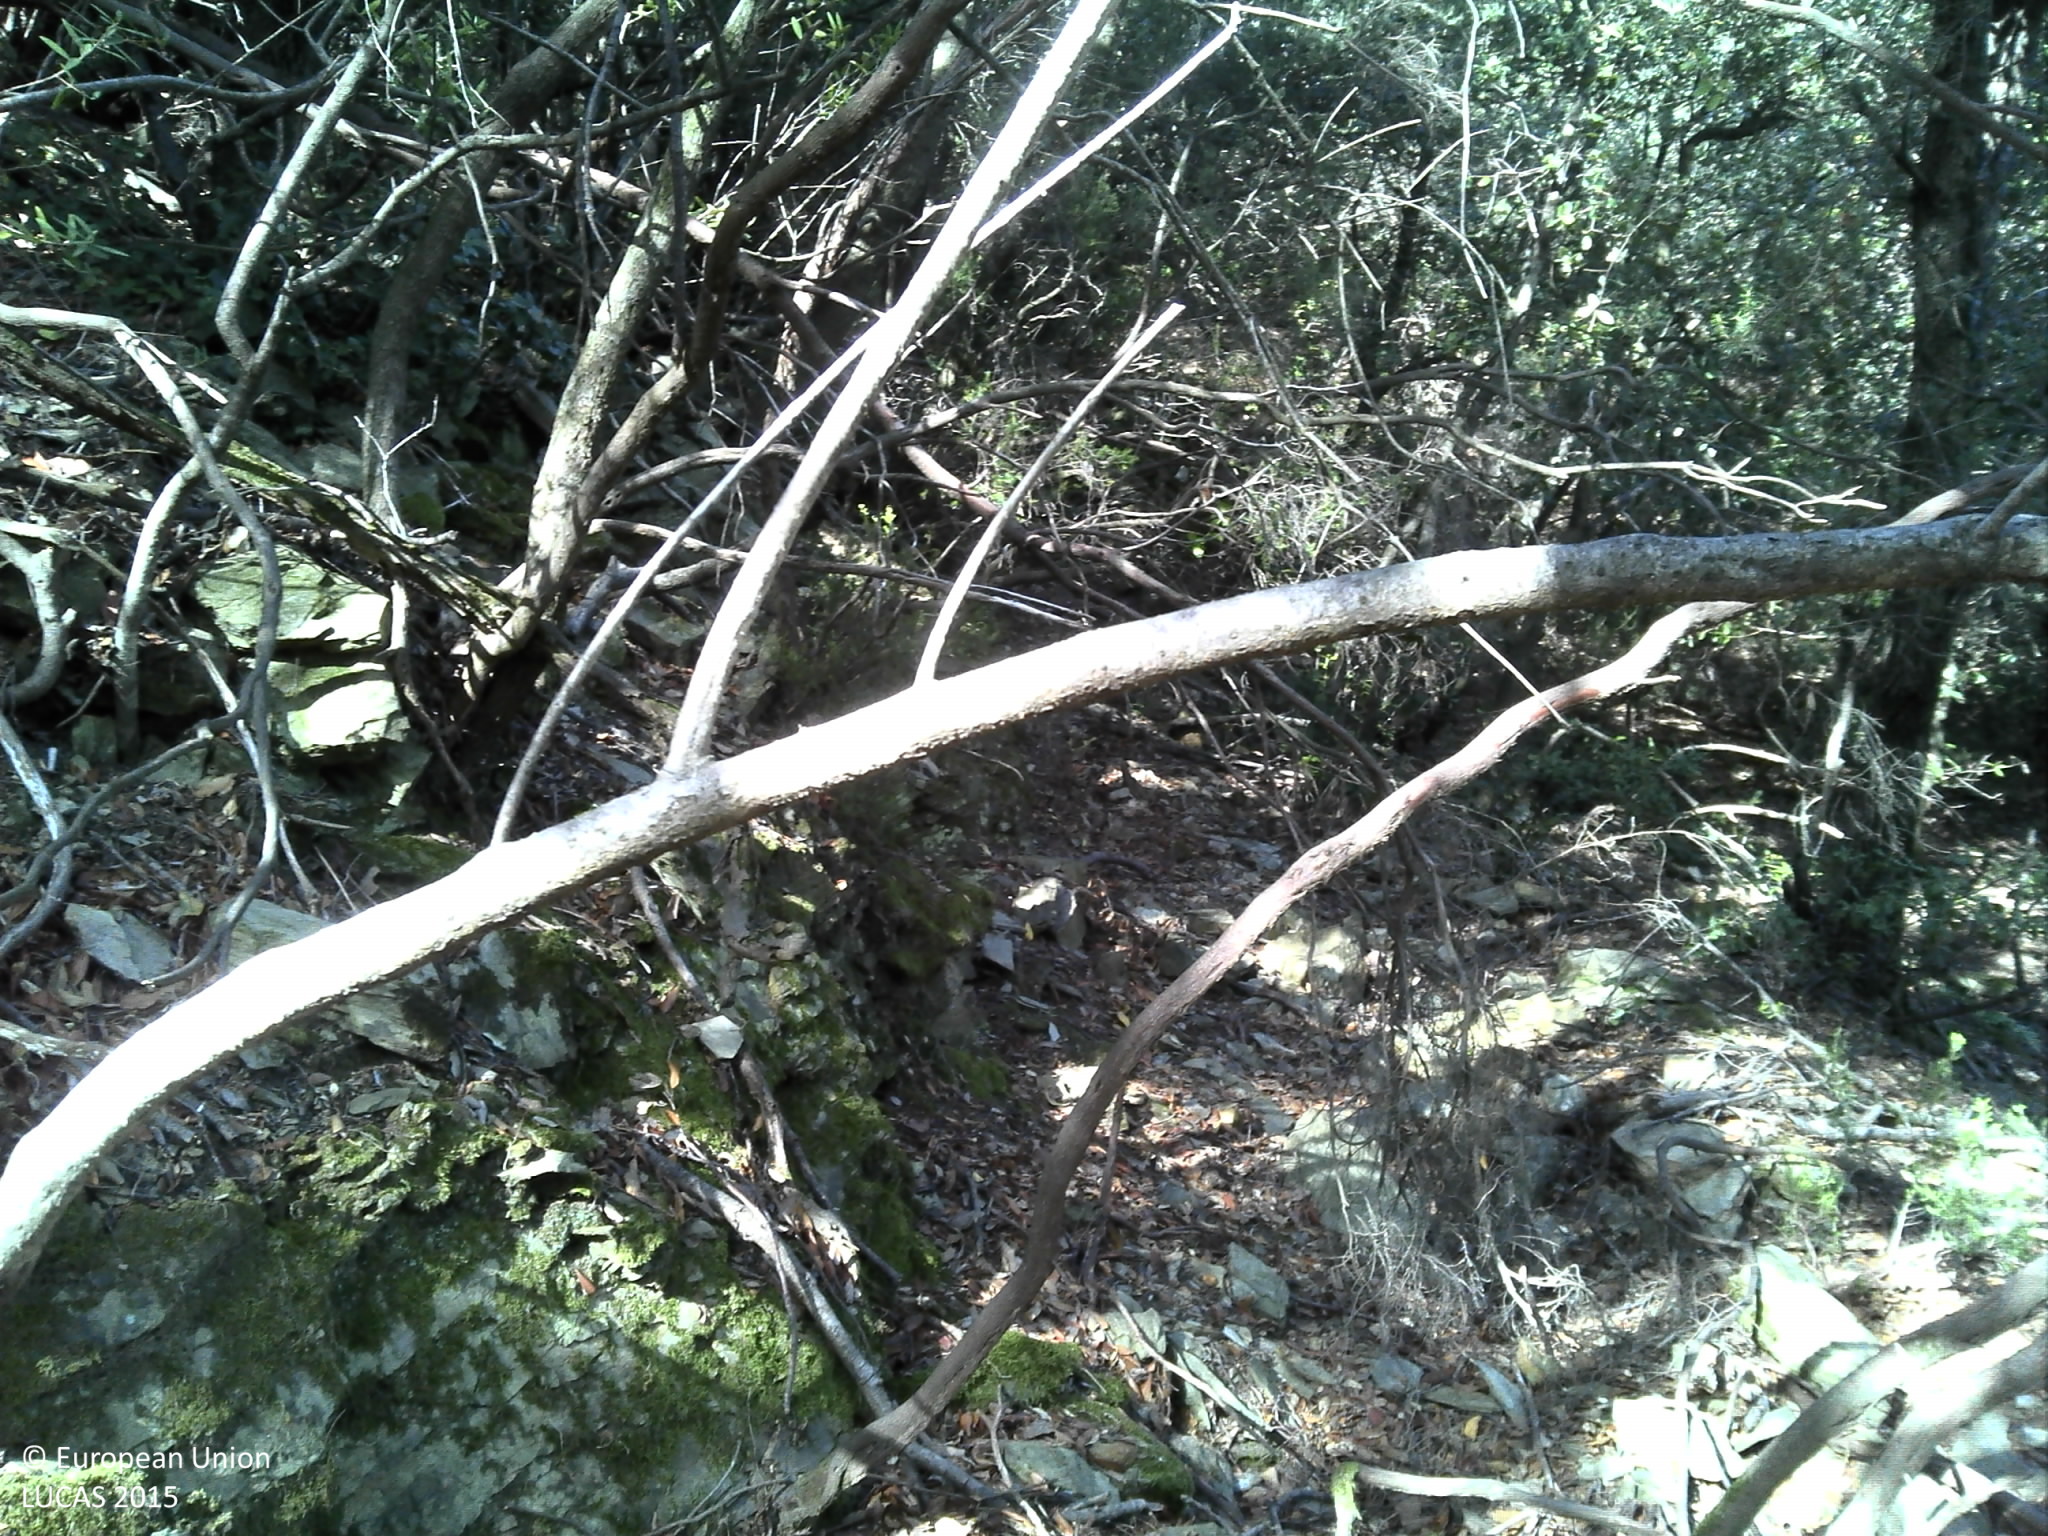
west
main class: Woodland
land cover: Broadleaved woodland
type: broadleaved evergreen forest
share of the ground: 50 - 75 %
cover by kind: broadleaved forest trees 70 %, consolidated bare surface 15 %, coniferous forest trees 5 %, shrubs 5 %, herbaceous plants 5 %
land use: Semi-natural and natural areas not in use
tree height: > 5 m
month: October
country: FR
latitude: 43.5475
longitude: 3.1886
